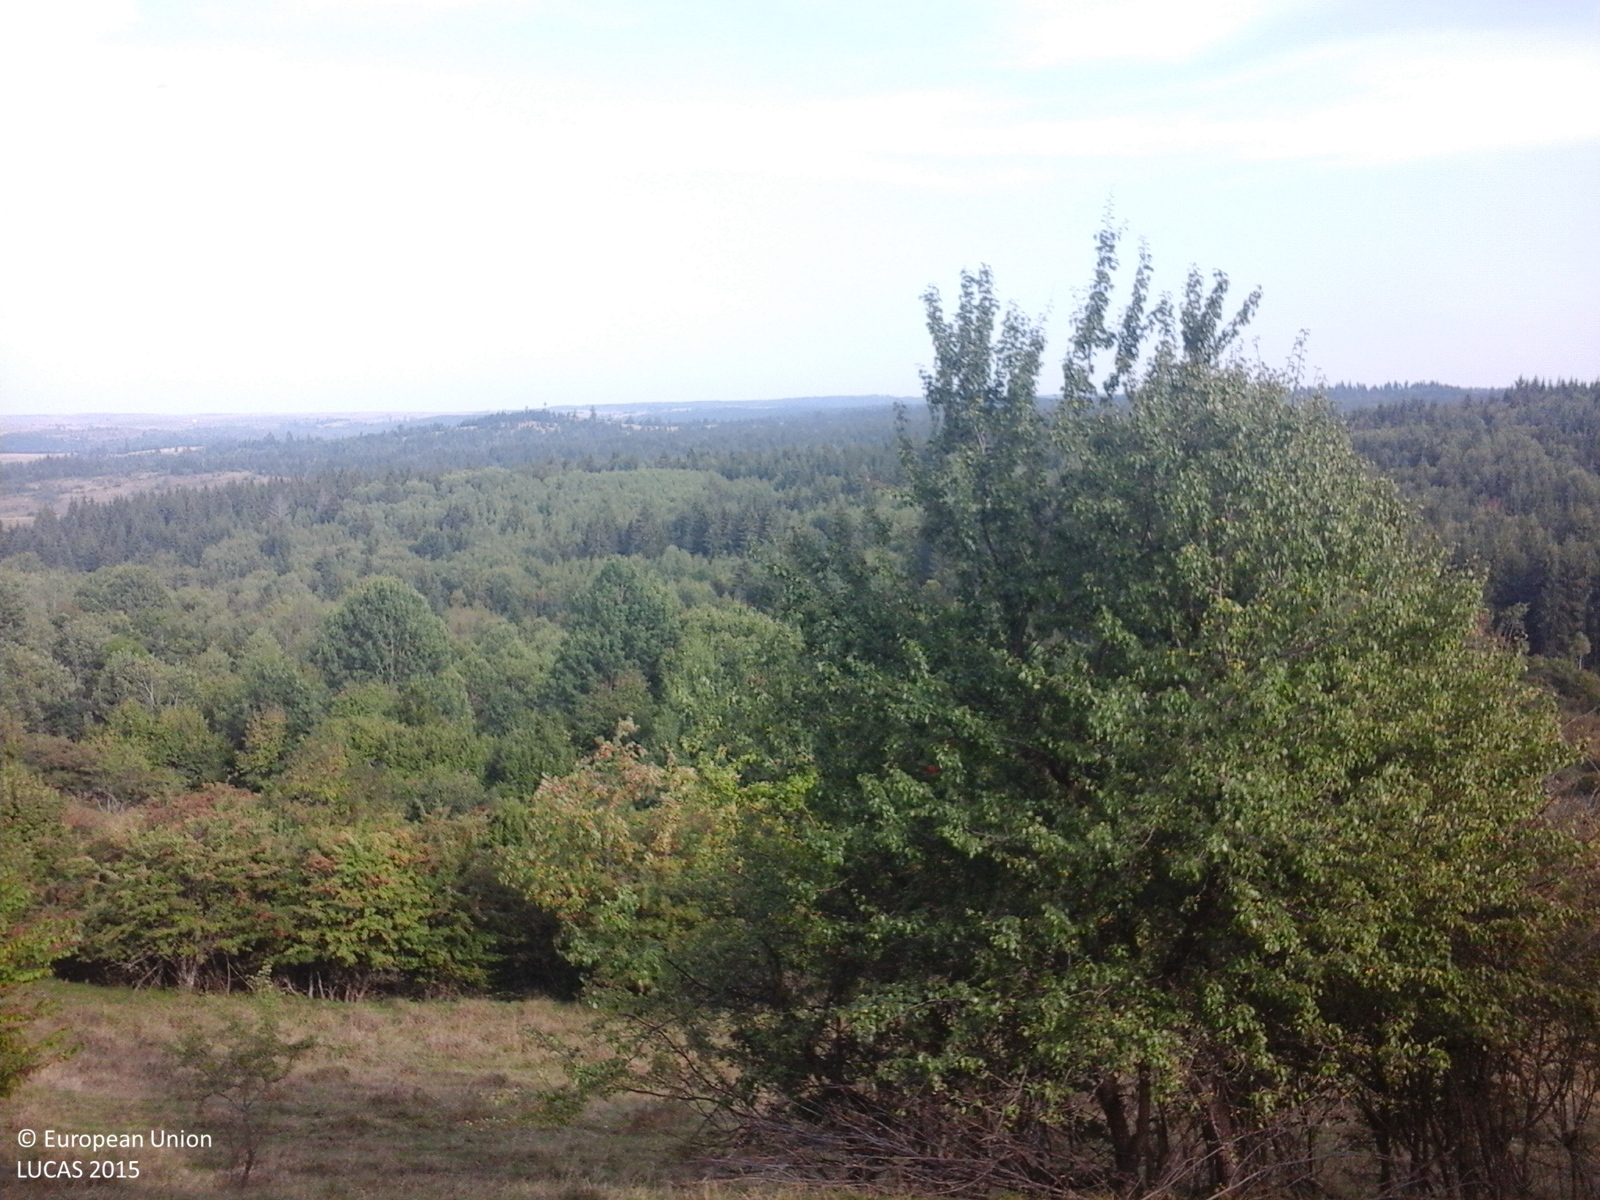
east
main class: Grassland
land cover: Grassland with sparse tree/shrub cover
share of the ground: > 75 %
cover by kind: herbaceous plants 85 %, shrubs 10 %, broadleaved forest trees 5 %
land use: Agriculture (excluding fallow land and kitchen gardens)
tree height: < 5 m
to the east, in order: Grassland with sparse tree/shrub cover; Grassland without tree/shrub cover; Abandoned hedges; Grassland without tree/shrub cover; Abandoned hedges; Grassland with sparse tree/shrub cover; Abandoned hedges; Grassland without tree/shrub cover; Spruce dominated mixed woodland
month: September
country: RO
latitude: 46.7416
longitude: 22.9785
